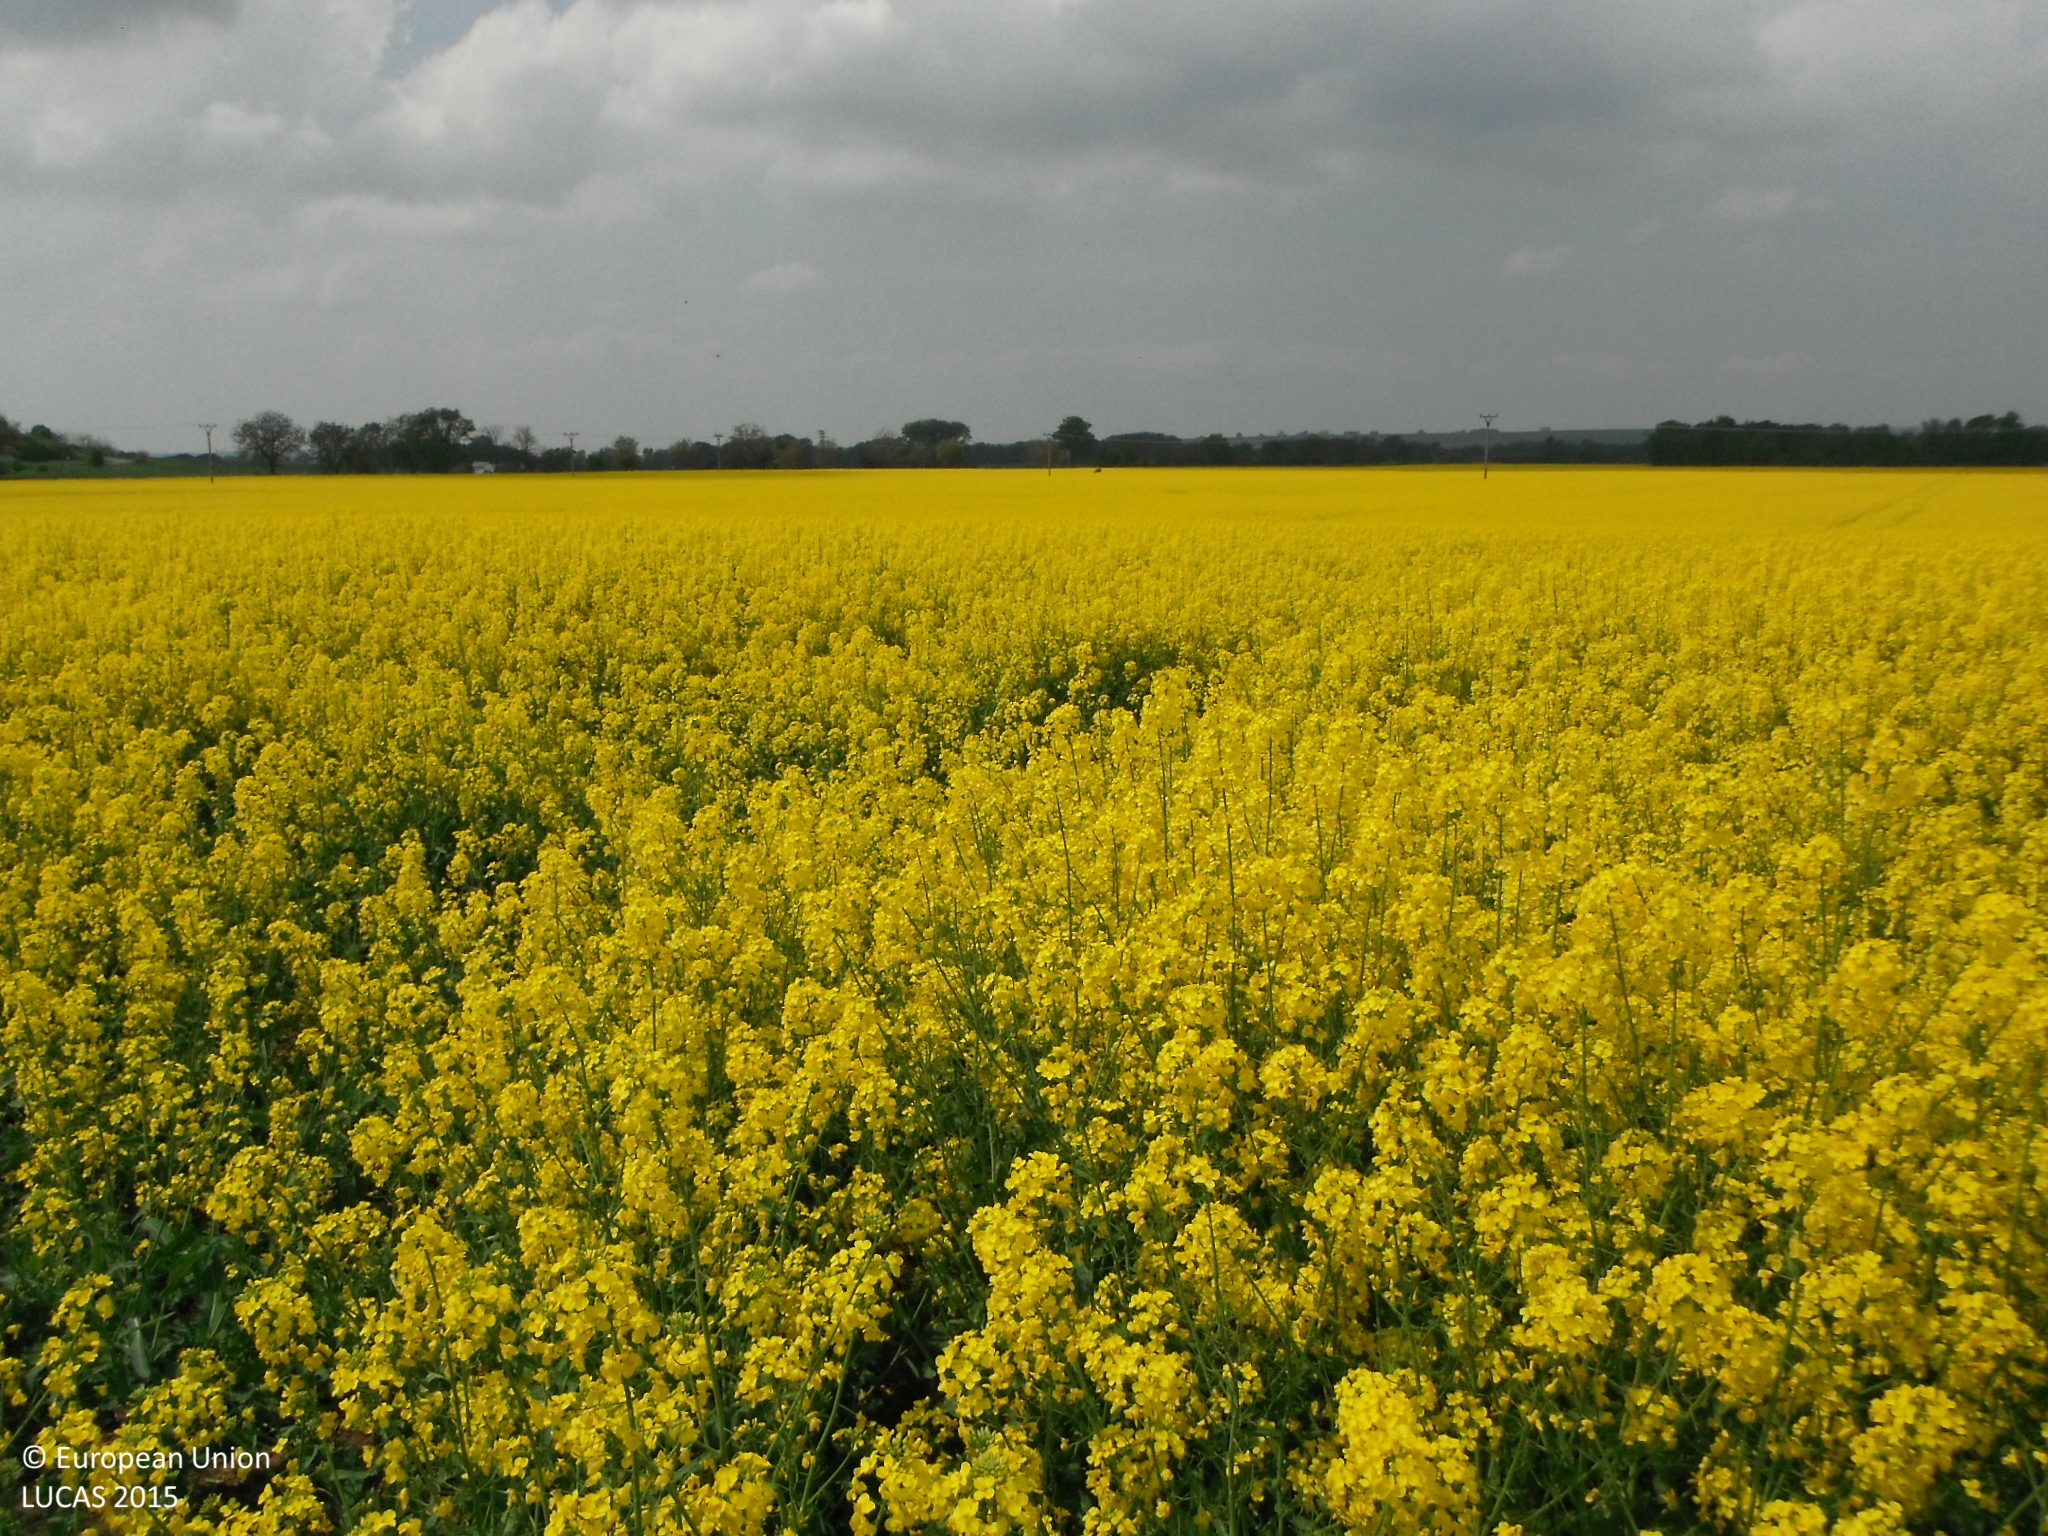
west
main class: Cropland
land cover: Rape and turnip rape
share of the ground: > 75 %
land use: Agriculture (excluding fallow land and kitchen gardens)
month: May
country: SK
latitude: 48.3950
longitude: 18.1039
